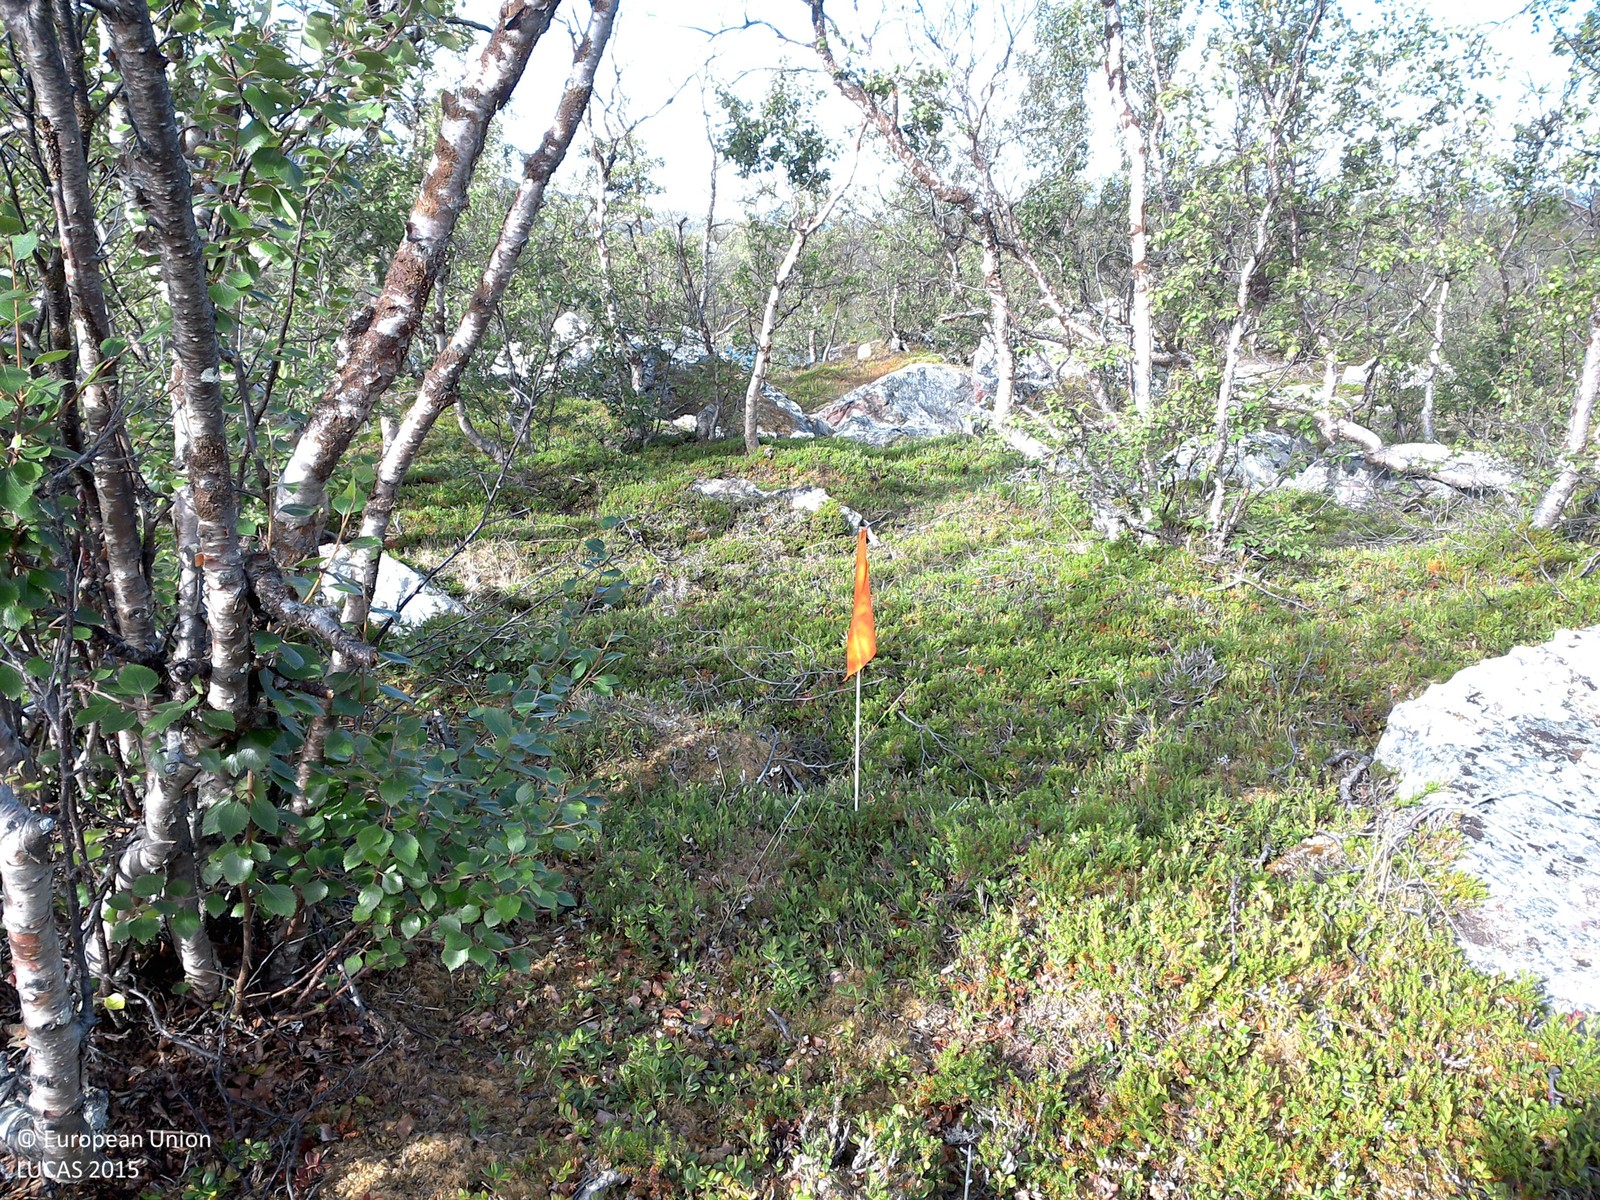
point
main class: Woodland
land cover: Broadleaved woodland
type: boreal forest
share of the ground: 10 - 25 %
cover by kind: shrubs 55 %, broadleaved forest trees 20 %, lichens and mosses 20 %, unconsolidated bare surface 5 %
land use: Amenities, museums, leisure
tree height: < 5 m
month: August
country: SE
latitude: 68.3500
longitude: 19.0885
